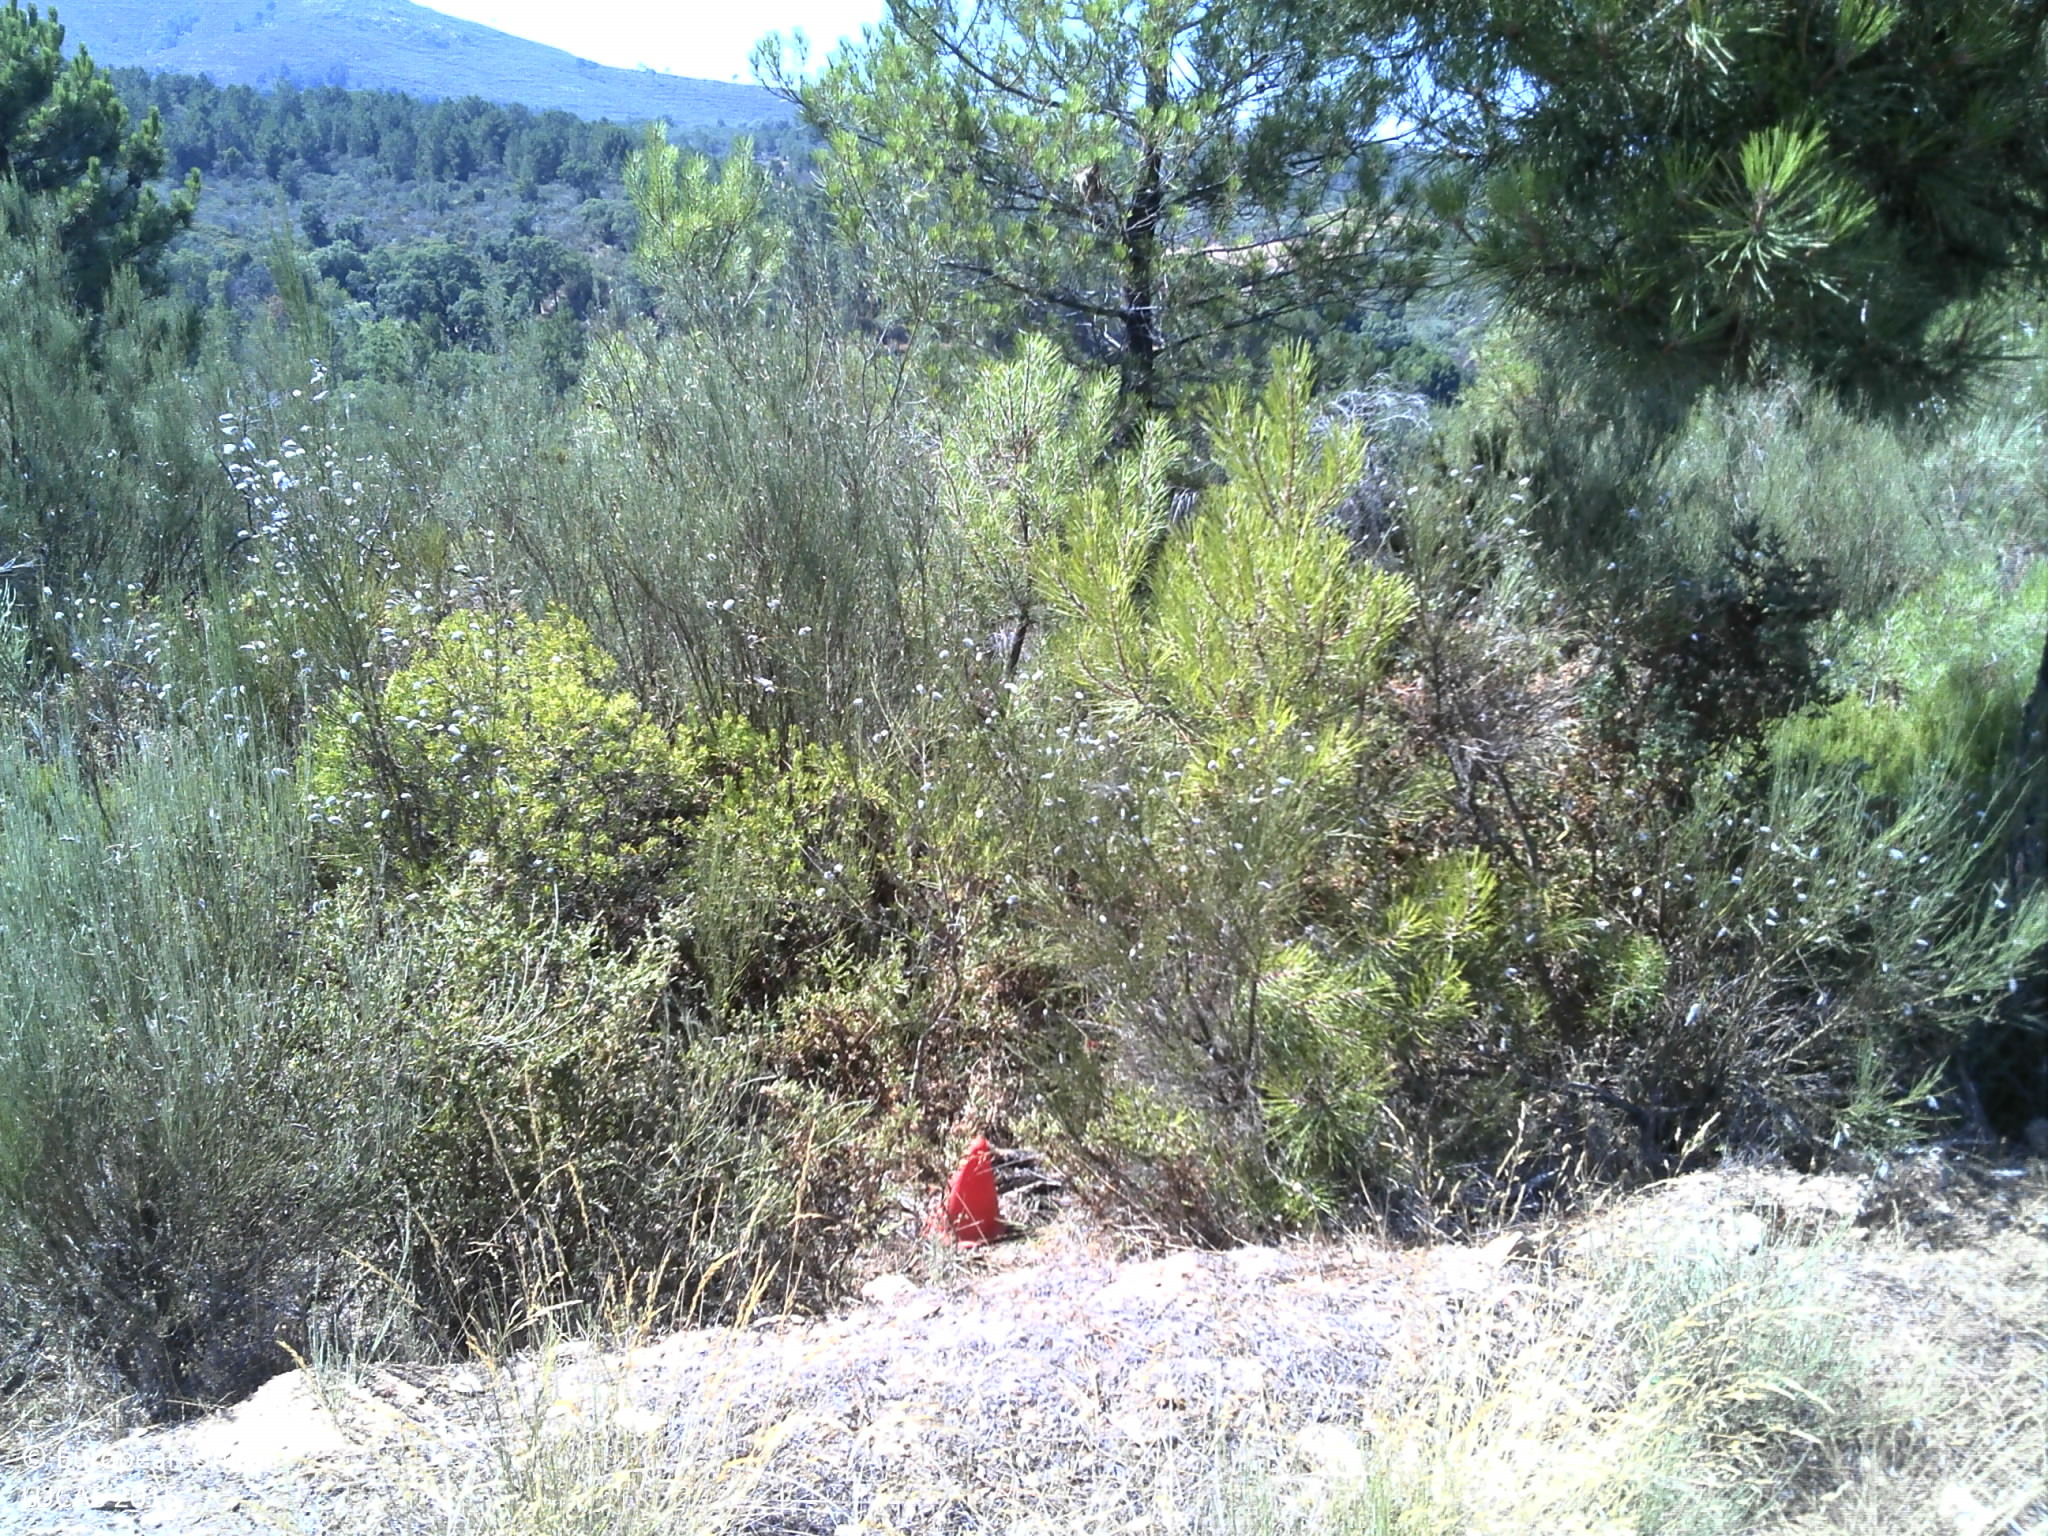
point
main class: Shrubland
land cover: Shrubland with sparse tree cover
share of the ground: > 75 %
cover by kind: shrubs 85 %, herbaceous plants 10 %, coniferous forest trees 5 %
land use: Abandoned areas
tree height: > 5 m
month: July
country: PT
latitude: 41.4730
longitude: -7.2560
